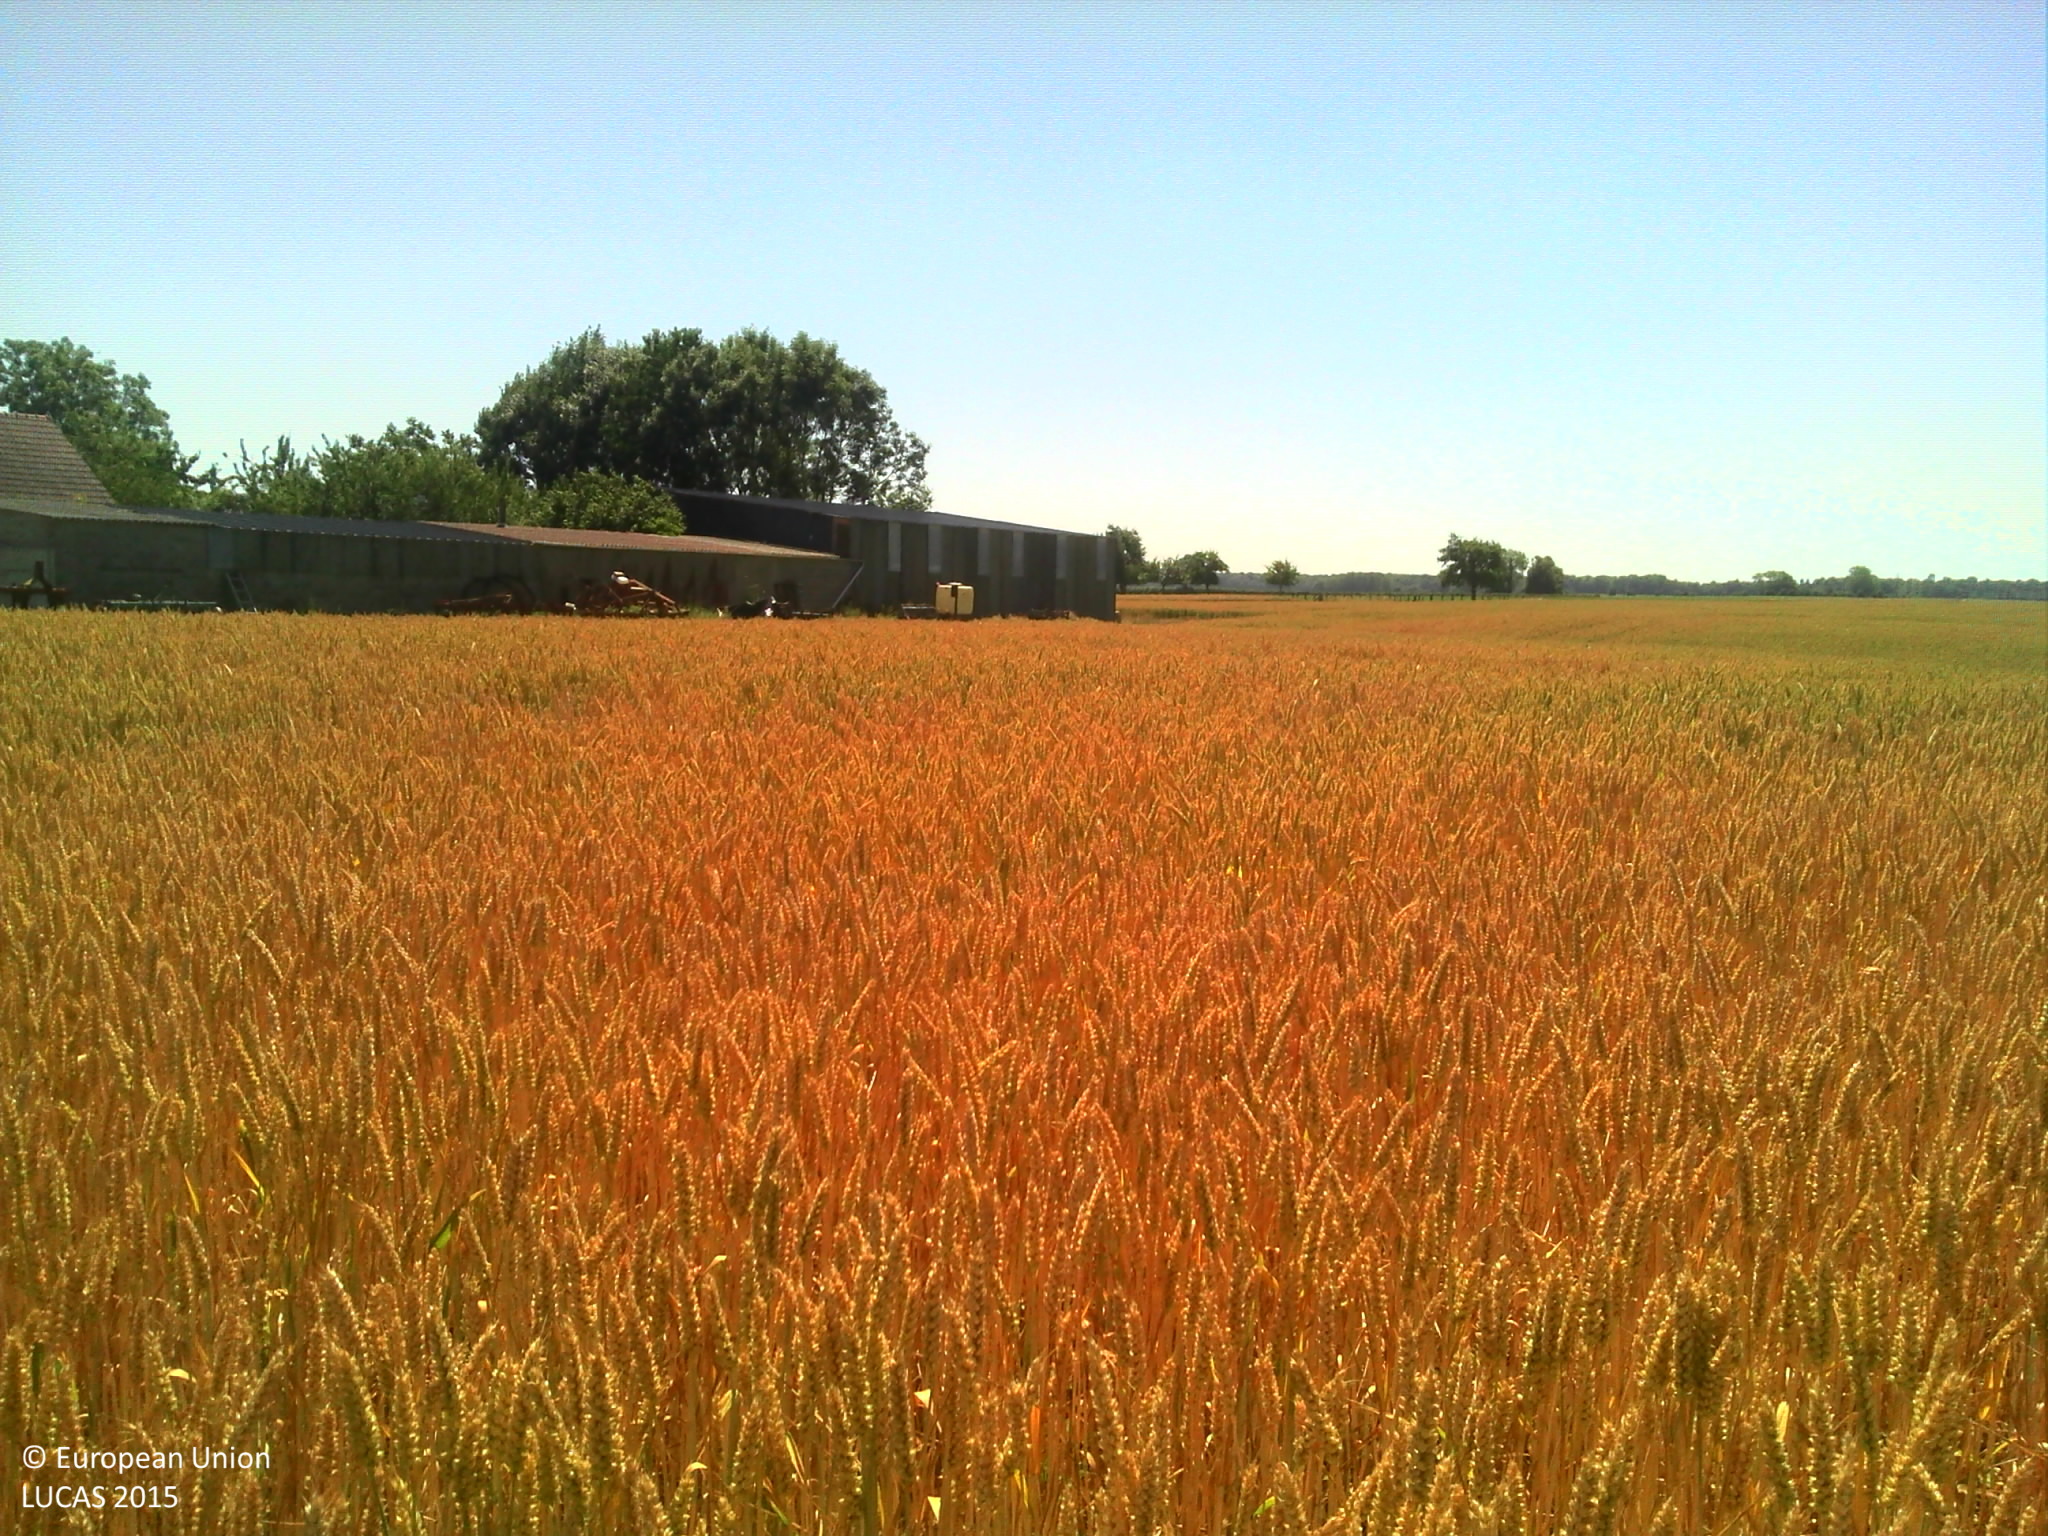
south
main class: Cropland
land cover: Common wheat
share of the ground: > 75 %
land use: Agriculture (excluding fallow land and kitchen gardens)
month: July
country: FR
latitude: 49.9370
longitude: 1.7205
